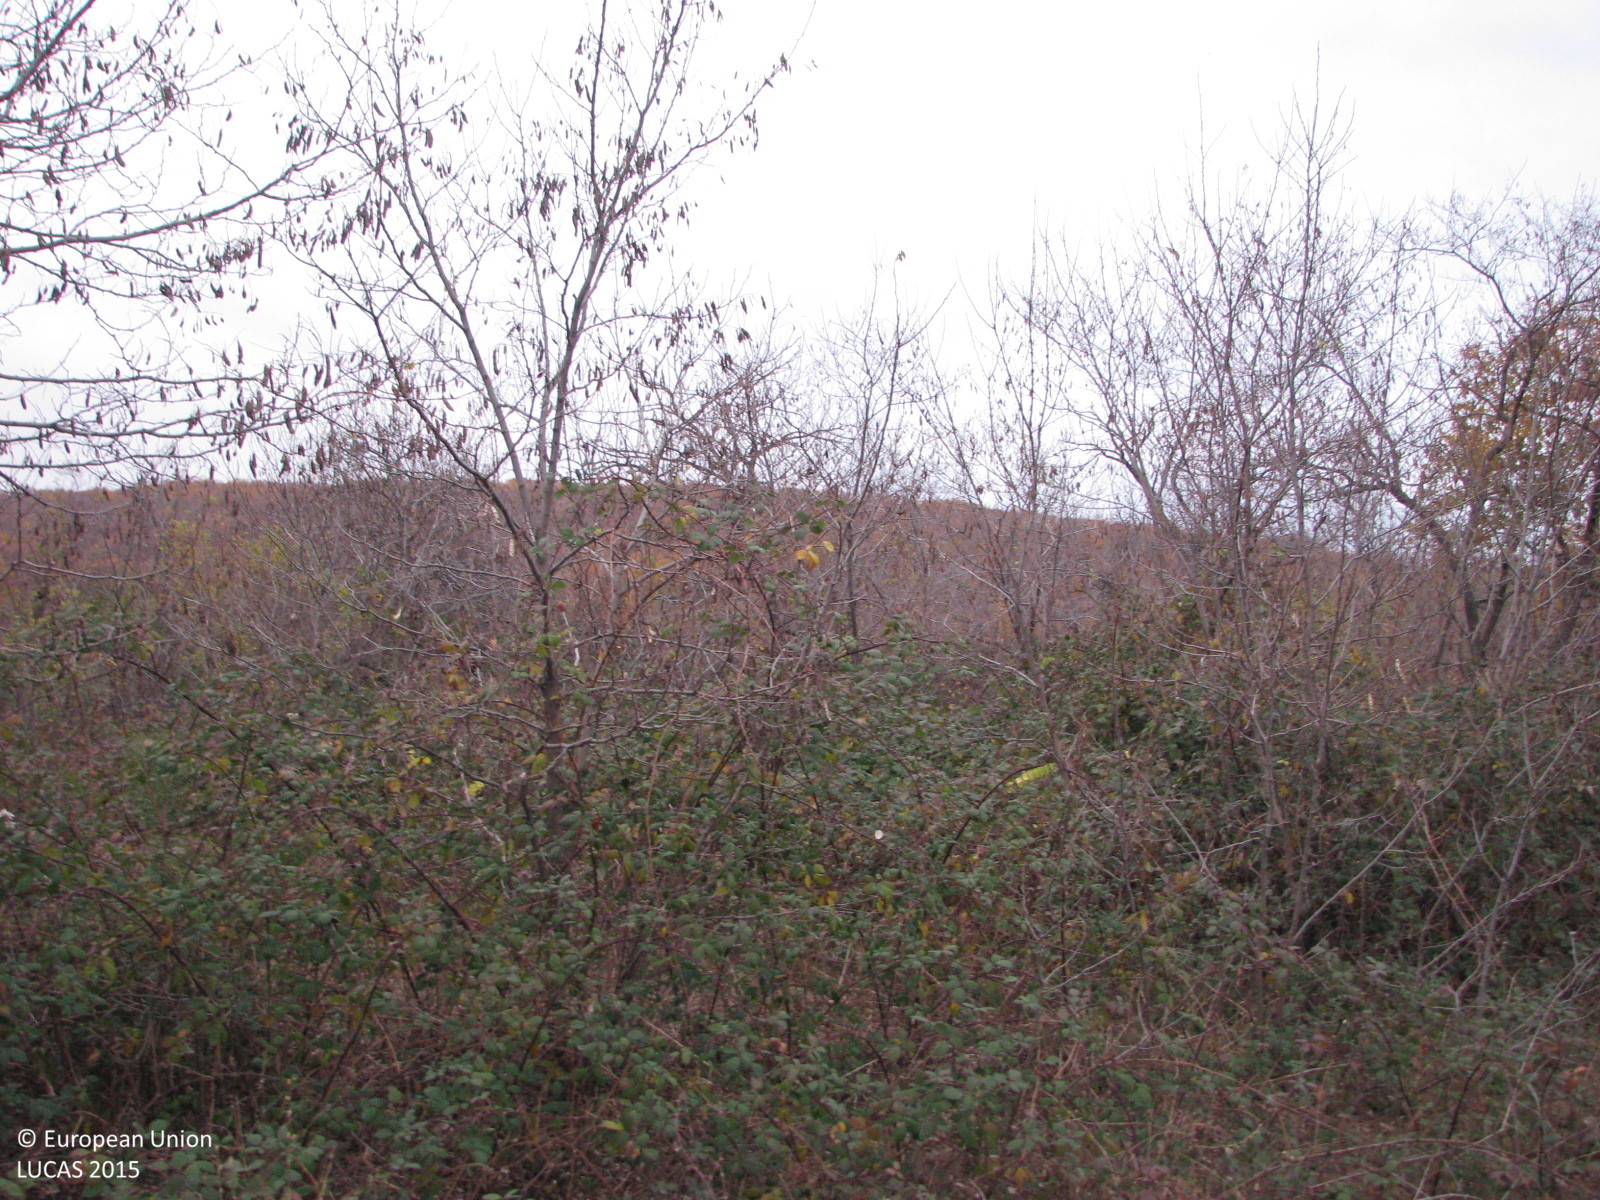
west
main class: Shrubland
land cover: Shrubland with sparse tree cover
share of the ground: > 75 %
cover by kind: shrubs 75 %, herbaceous plants 20 %, broadleaved forest trees 5 %
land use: Fallow land
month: December
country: BG
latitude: 42.3236
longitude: 24.0816
